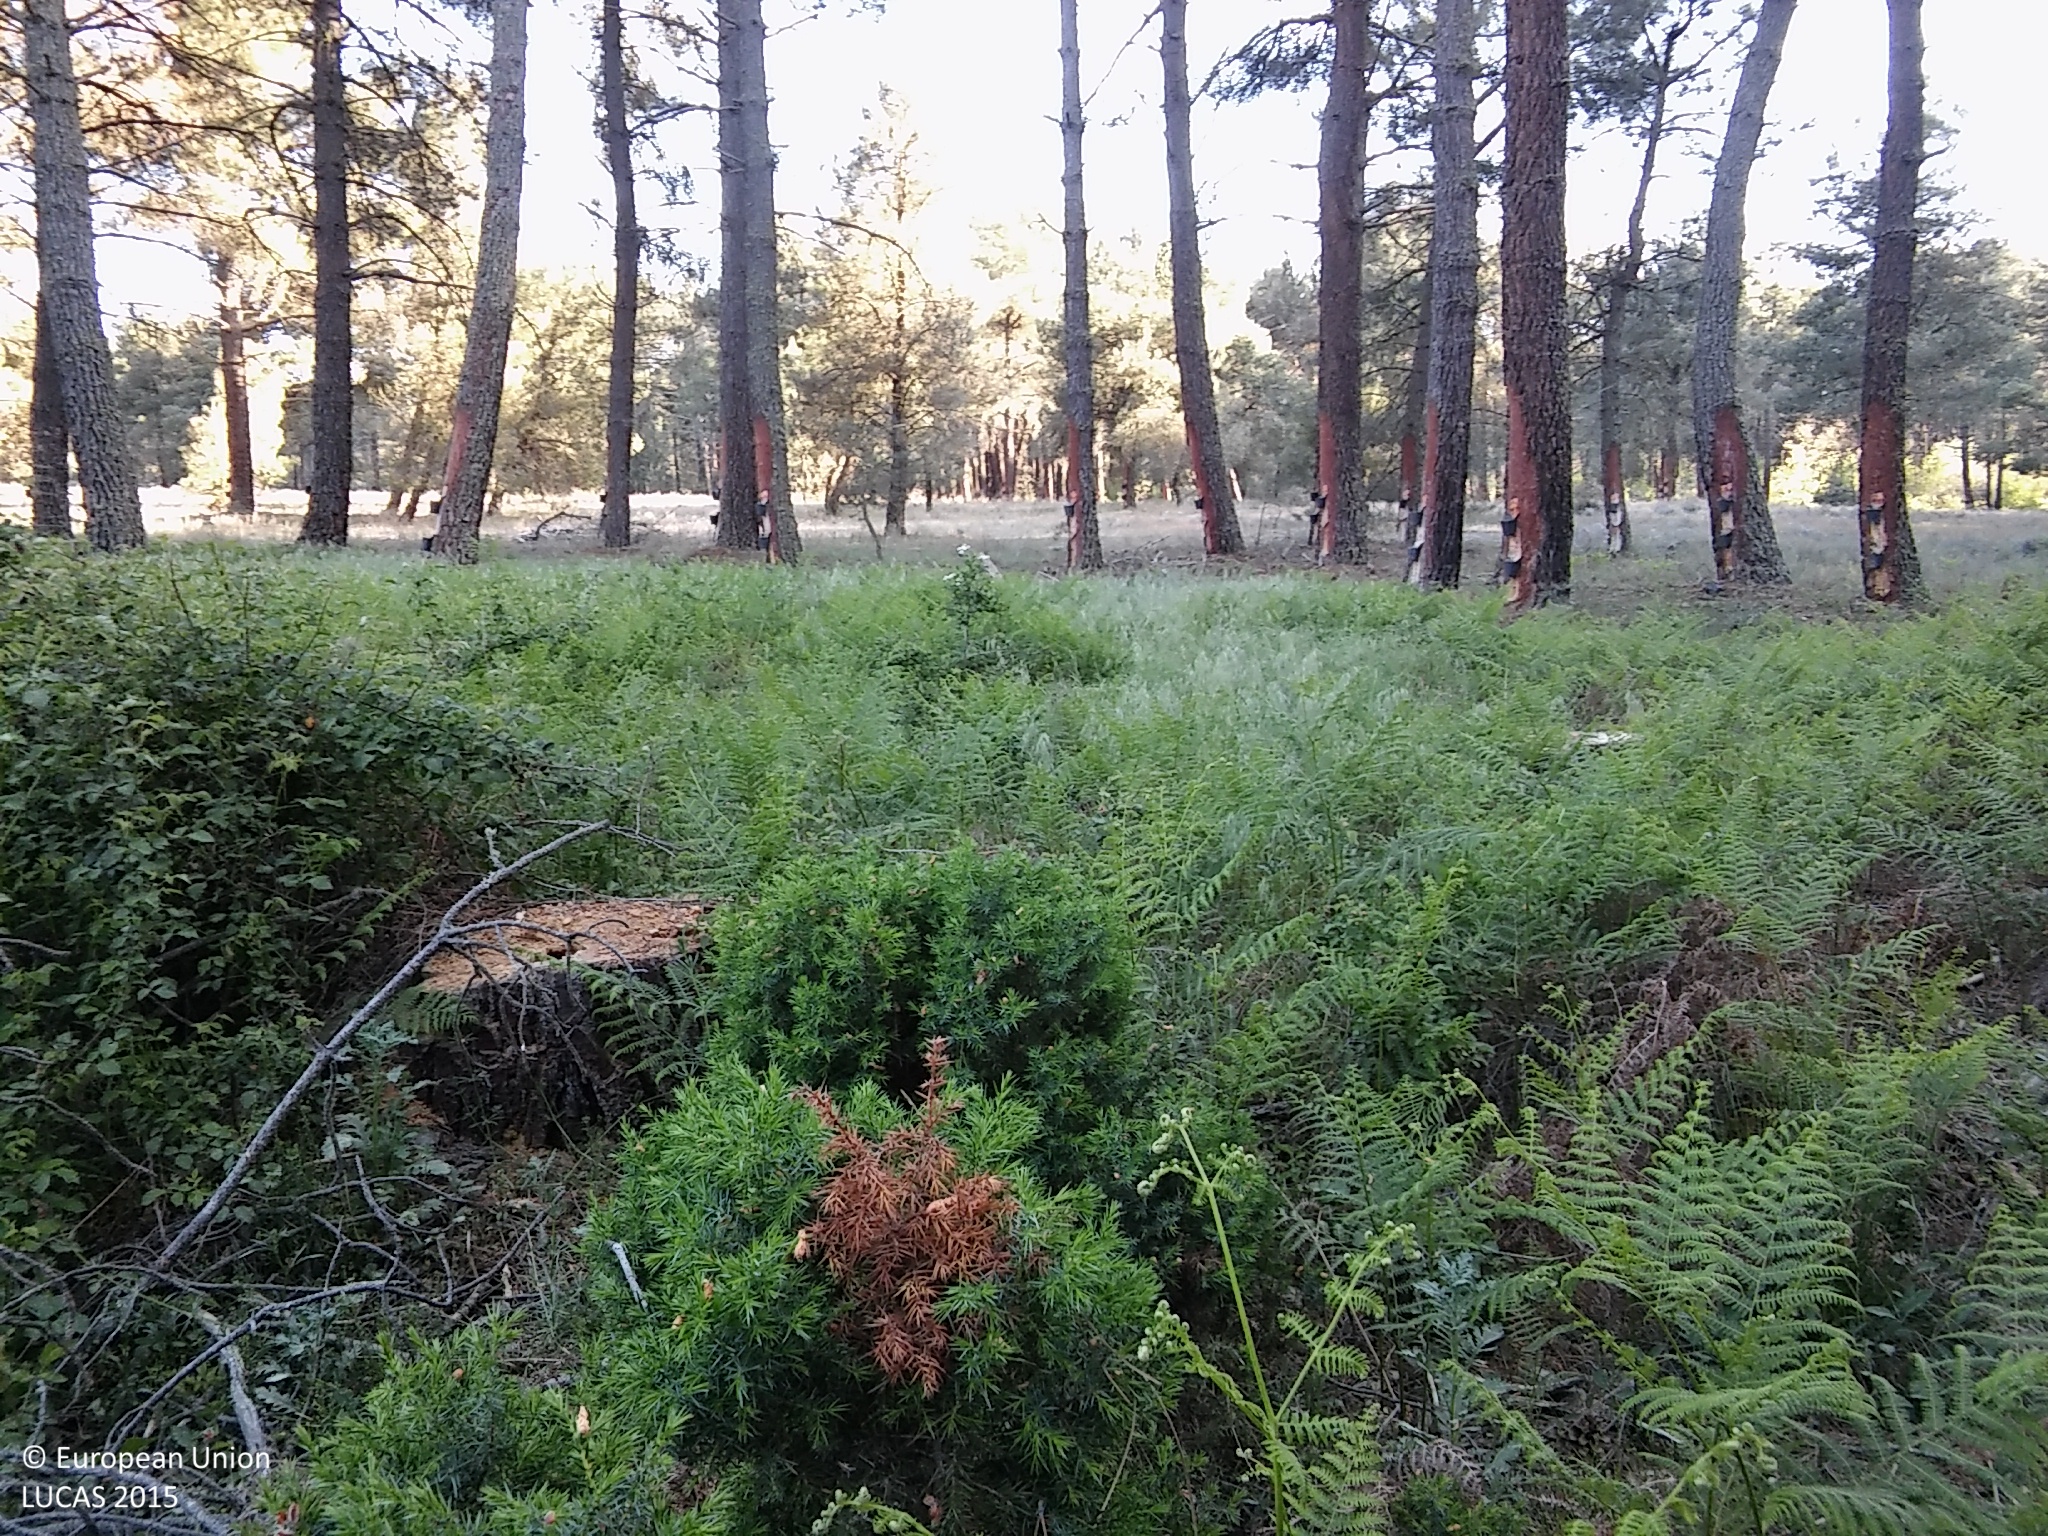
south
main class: Woodland
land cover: Pine dominated mixed woodland
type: coniferous forest of the mediterranean region
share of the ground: 50 - 75 %
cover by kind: coniferous forest trees 55 %, broadleaved forest trees 20 %, shrubs 20 %, herbaceous plants 5 %
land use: Forestry
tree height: > 5 m
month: May
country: ES
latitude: 41.3466
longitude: -4.0007
